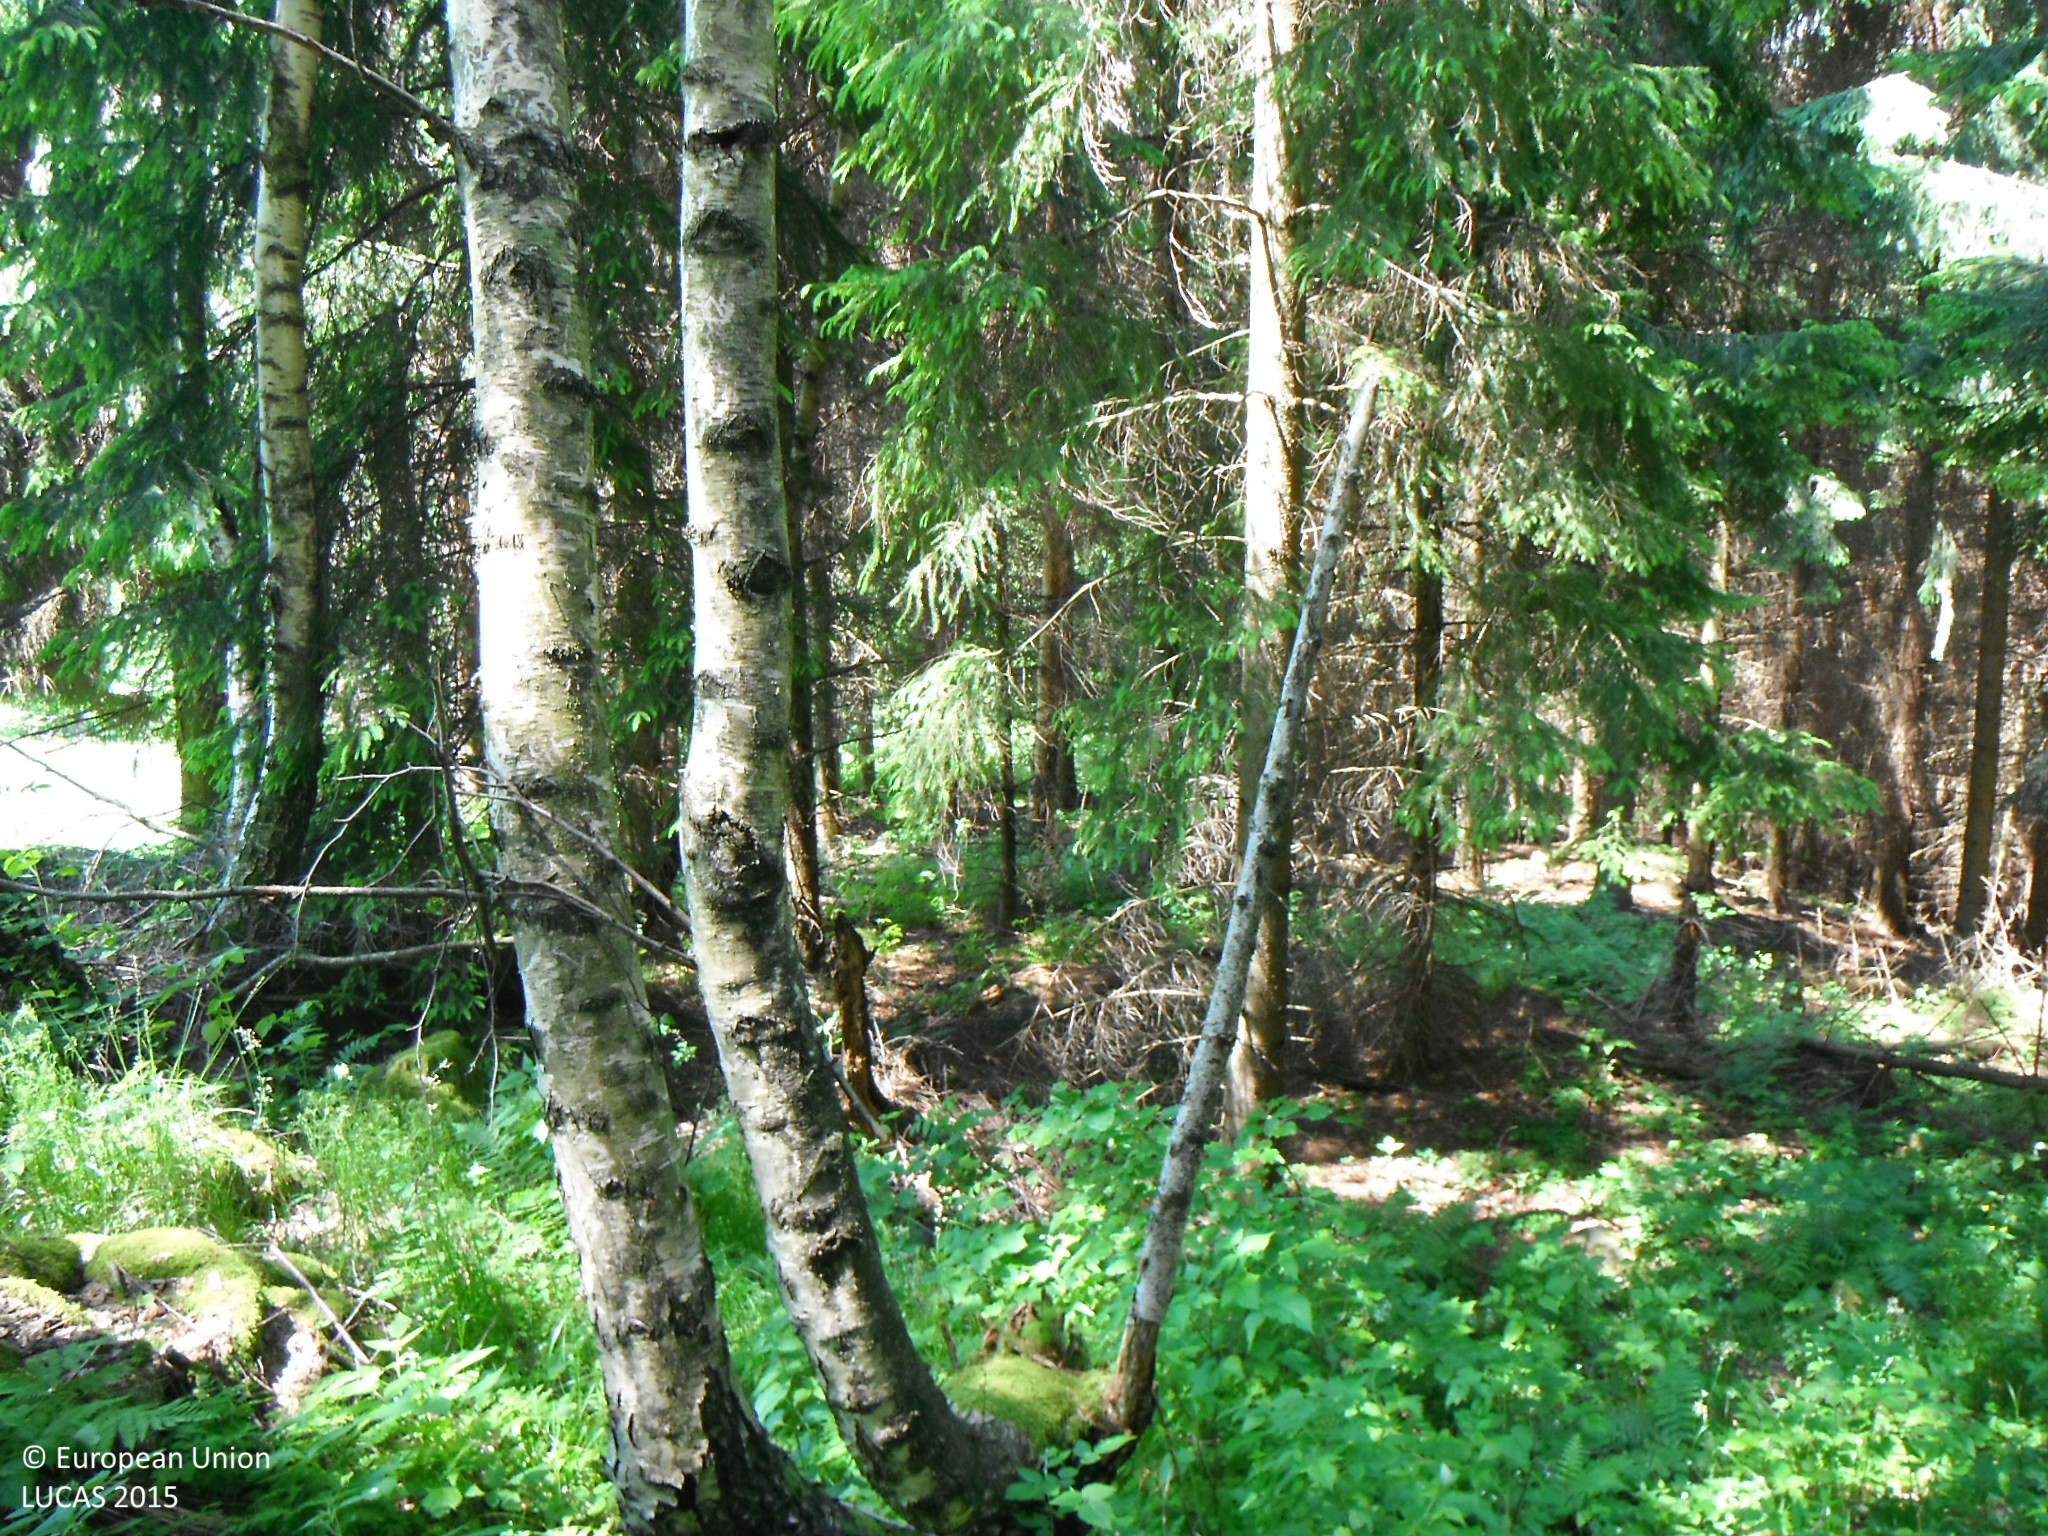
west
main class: Woodland
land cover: Spruce dominated coniferous woodland
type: alpine coniferous forest
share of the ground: > 75 %
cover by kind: coniferous forest trees 75 %, broadleaved forest trees 10 %, herbaceous plants 10 %, shrubs 5 %
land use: Forestry
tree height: > 5 m
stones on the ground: < 10 %
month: June
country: SK
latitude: 48.5678
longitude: 19.7712
